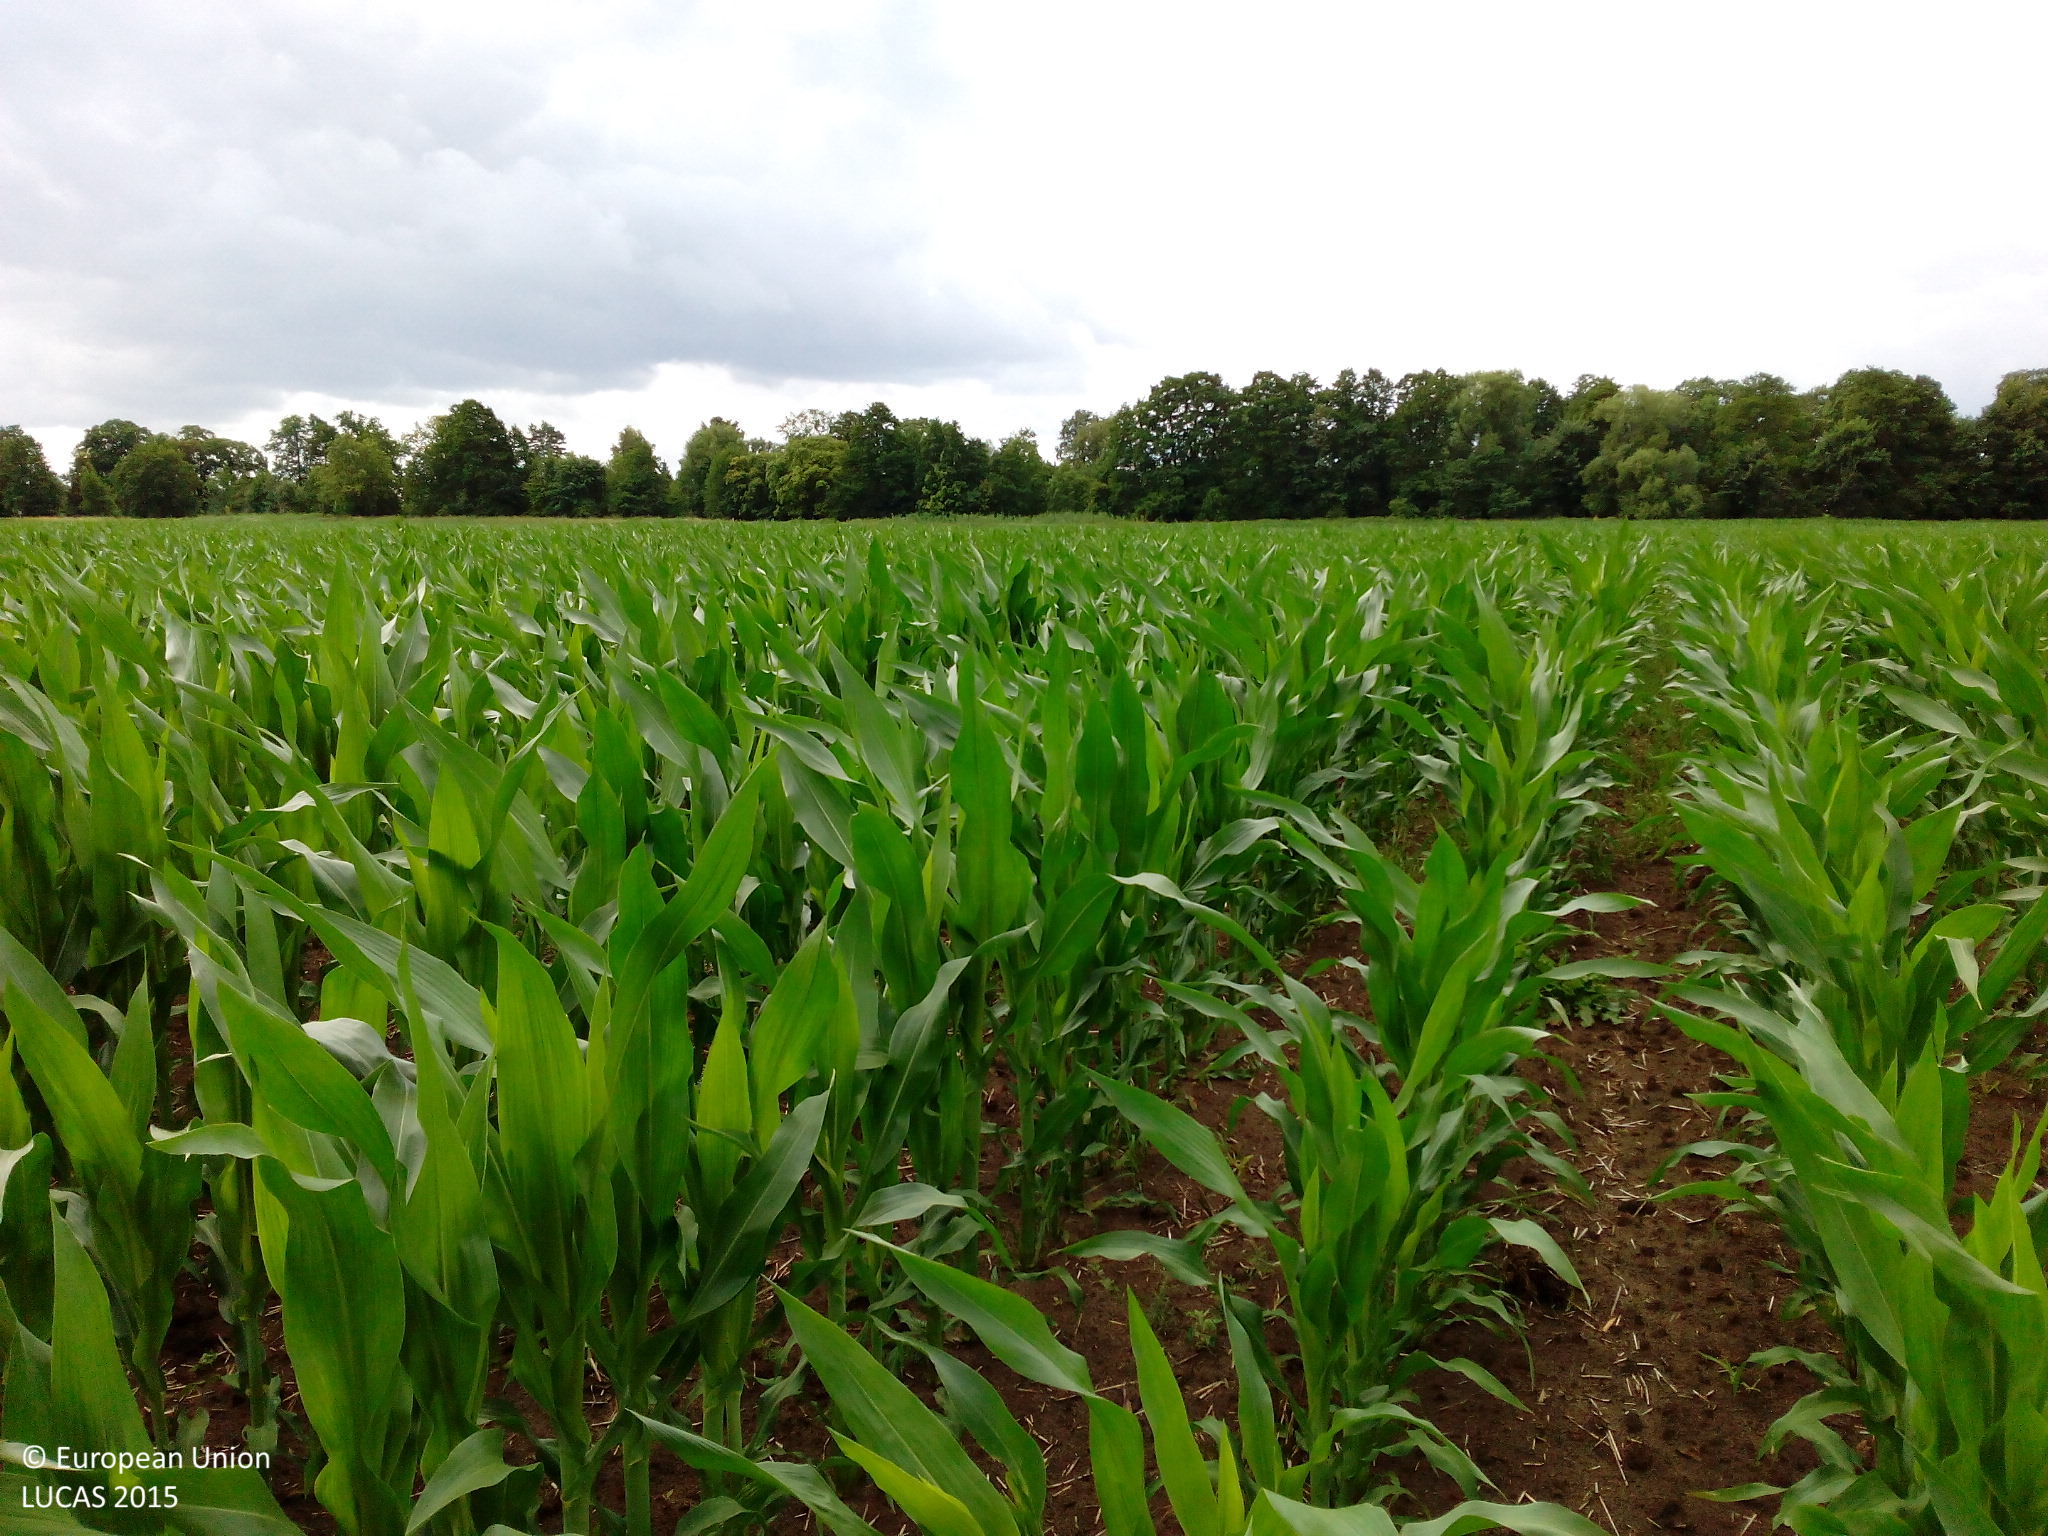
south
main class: Cropland
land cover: Maize
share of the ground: 50 - 75 %
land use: Agriculture (excluding fallow land and kitchen gardens)
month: July
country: DE
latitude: 52.8462
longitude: 13.5488
